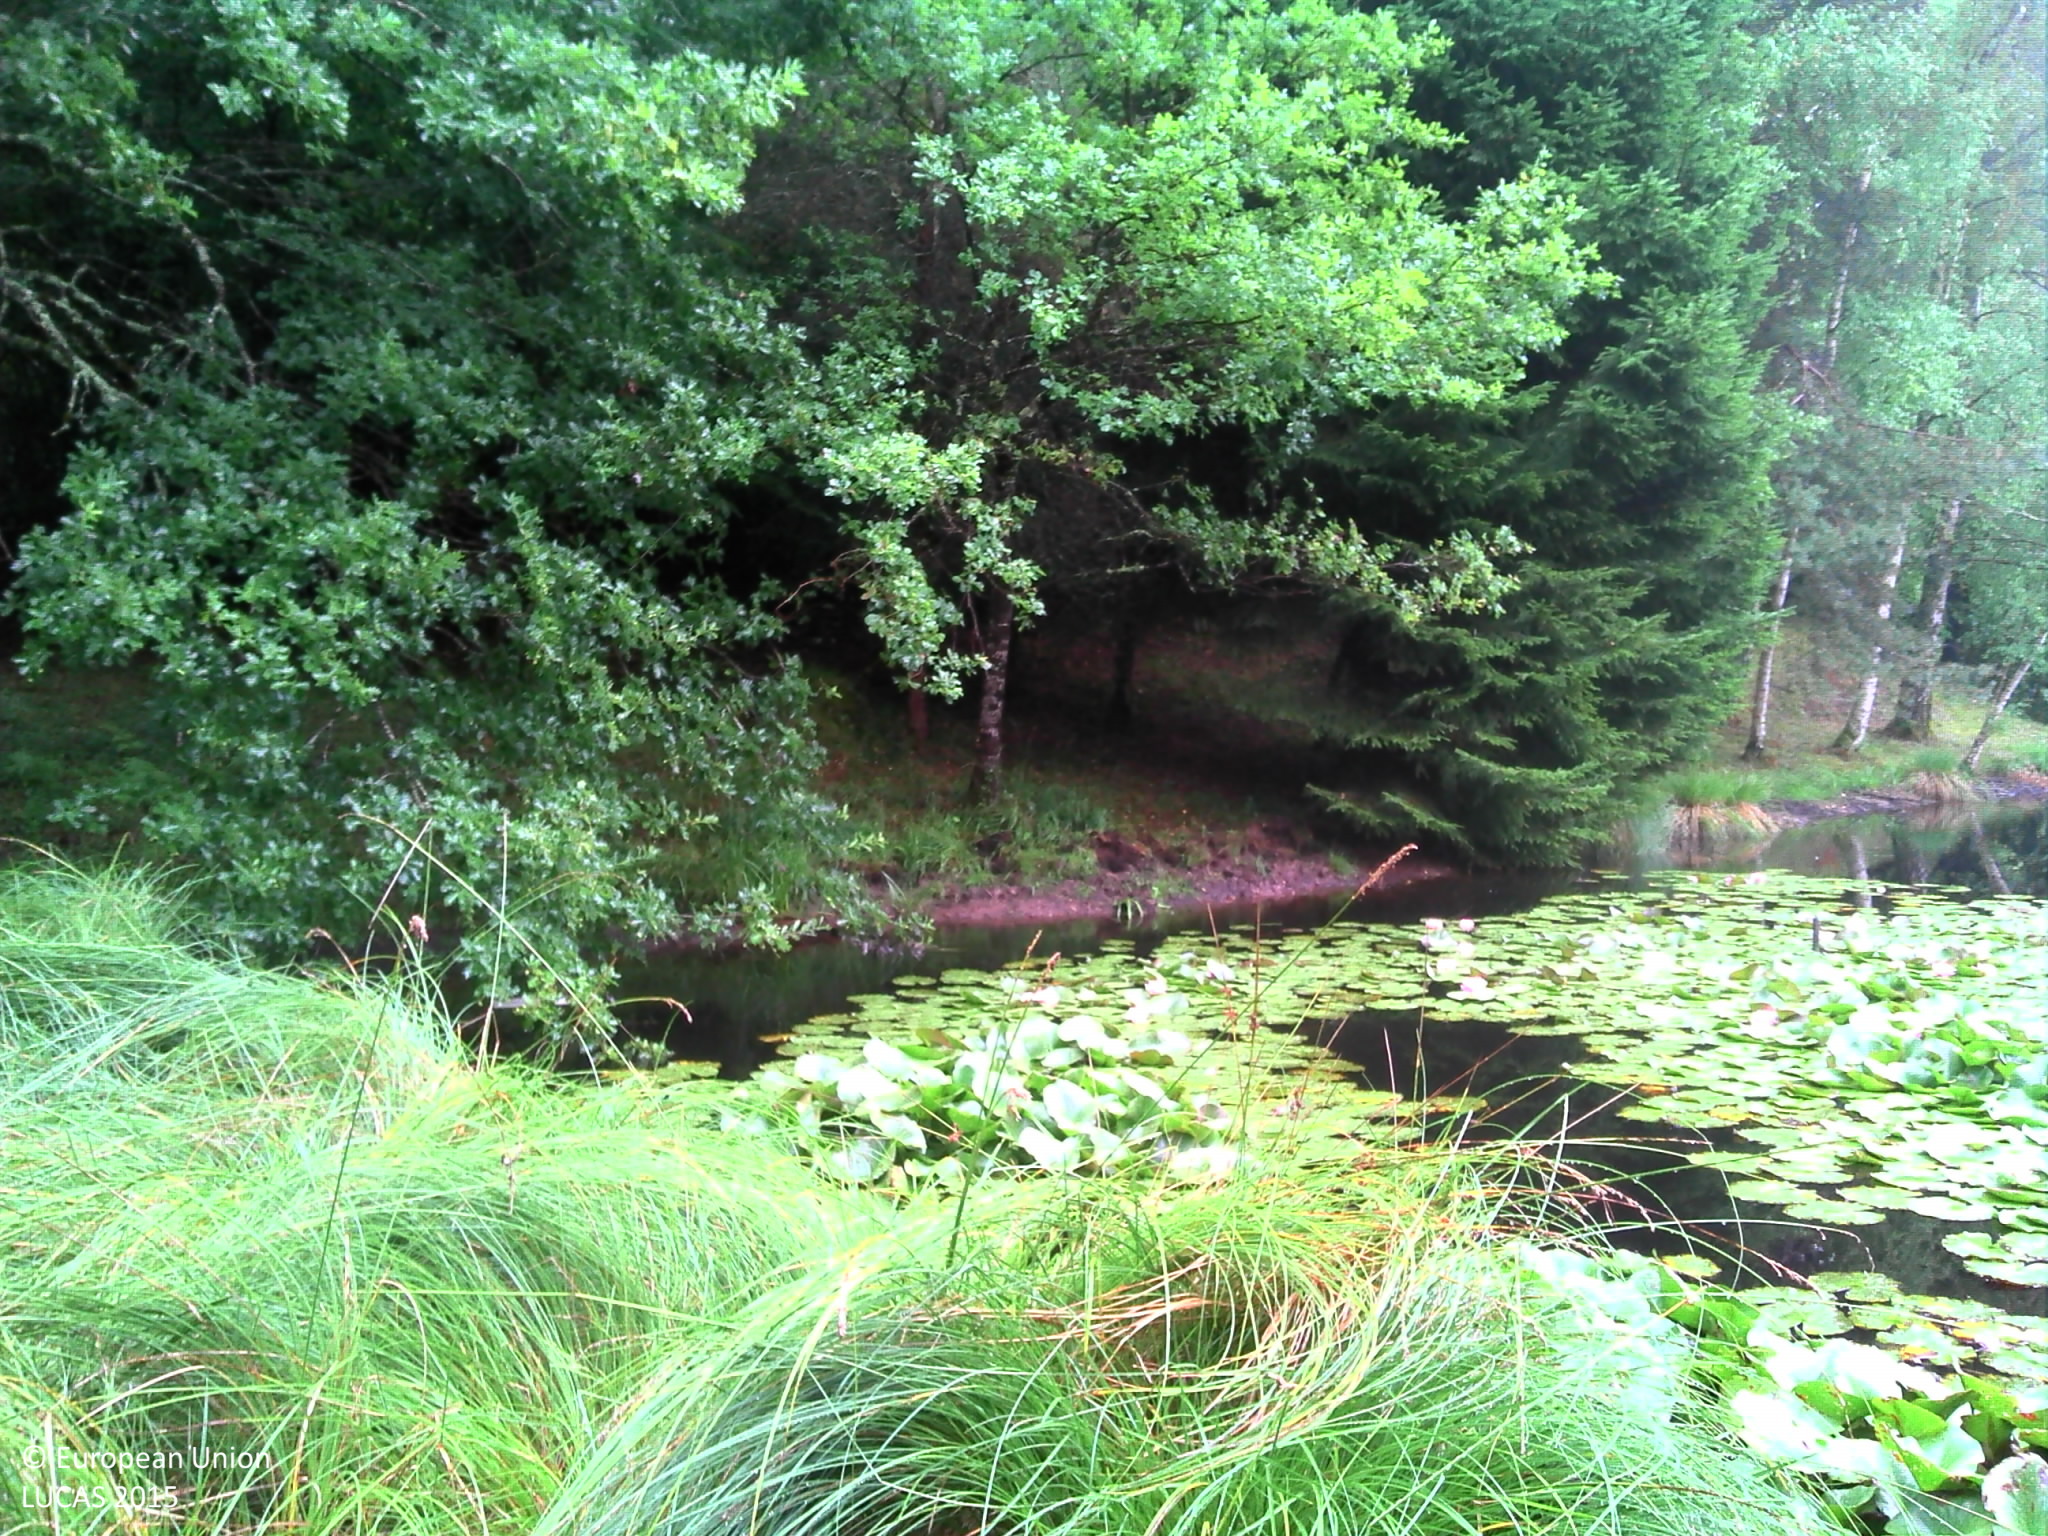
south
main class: Grassland
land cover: Grassland without tree/shrub cover
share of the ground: > 75 %
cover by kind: herbaceous plants 95 %, shrubs 5 %
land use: Forestry
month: August
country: FR
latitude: 45.5489
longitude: 0.7277
